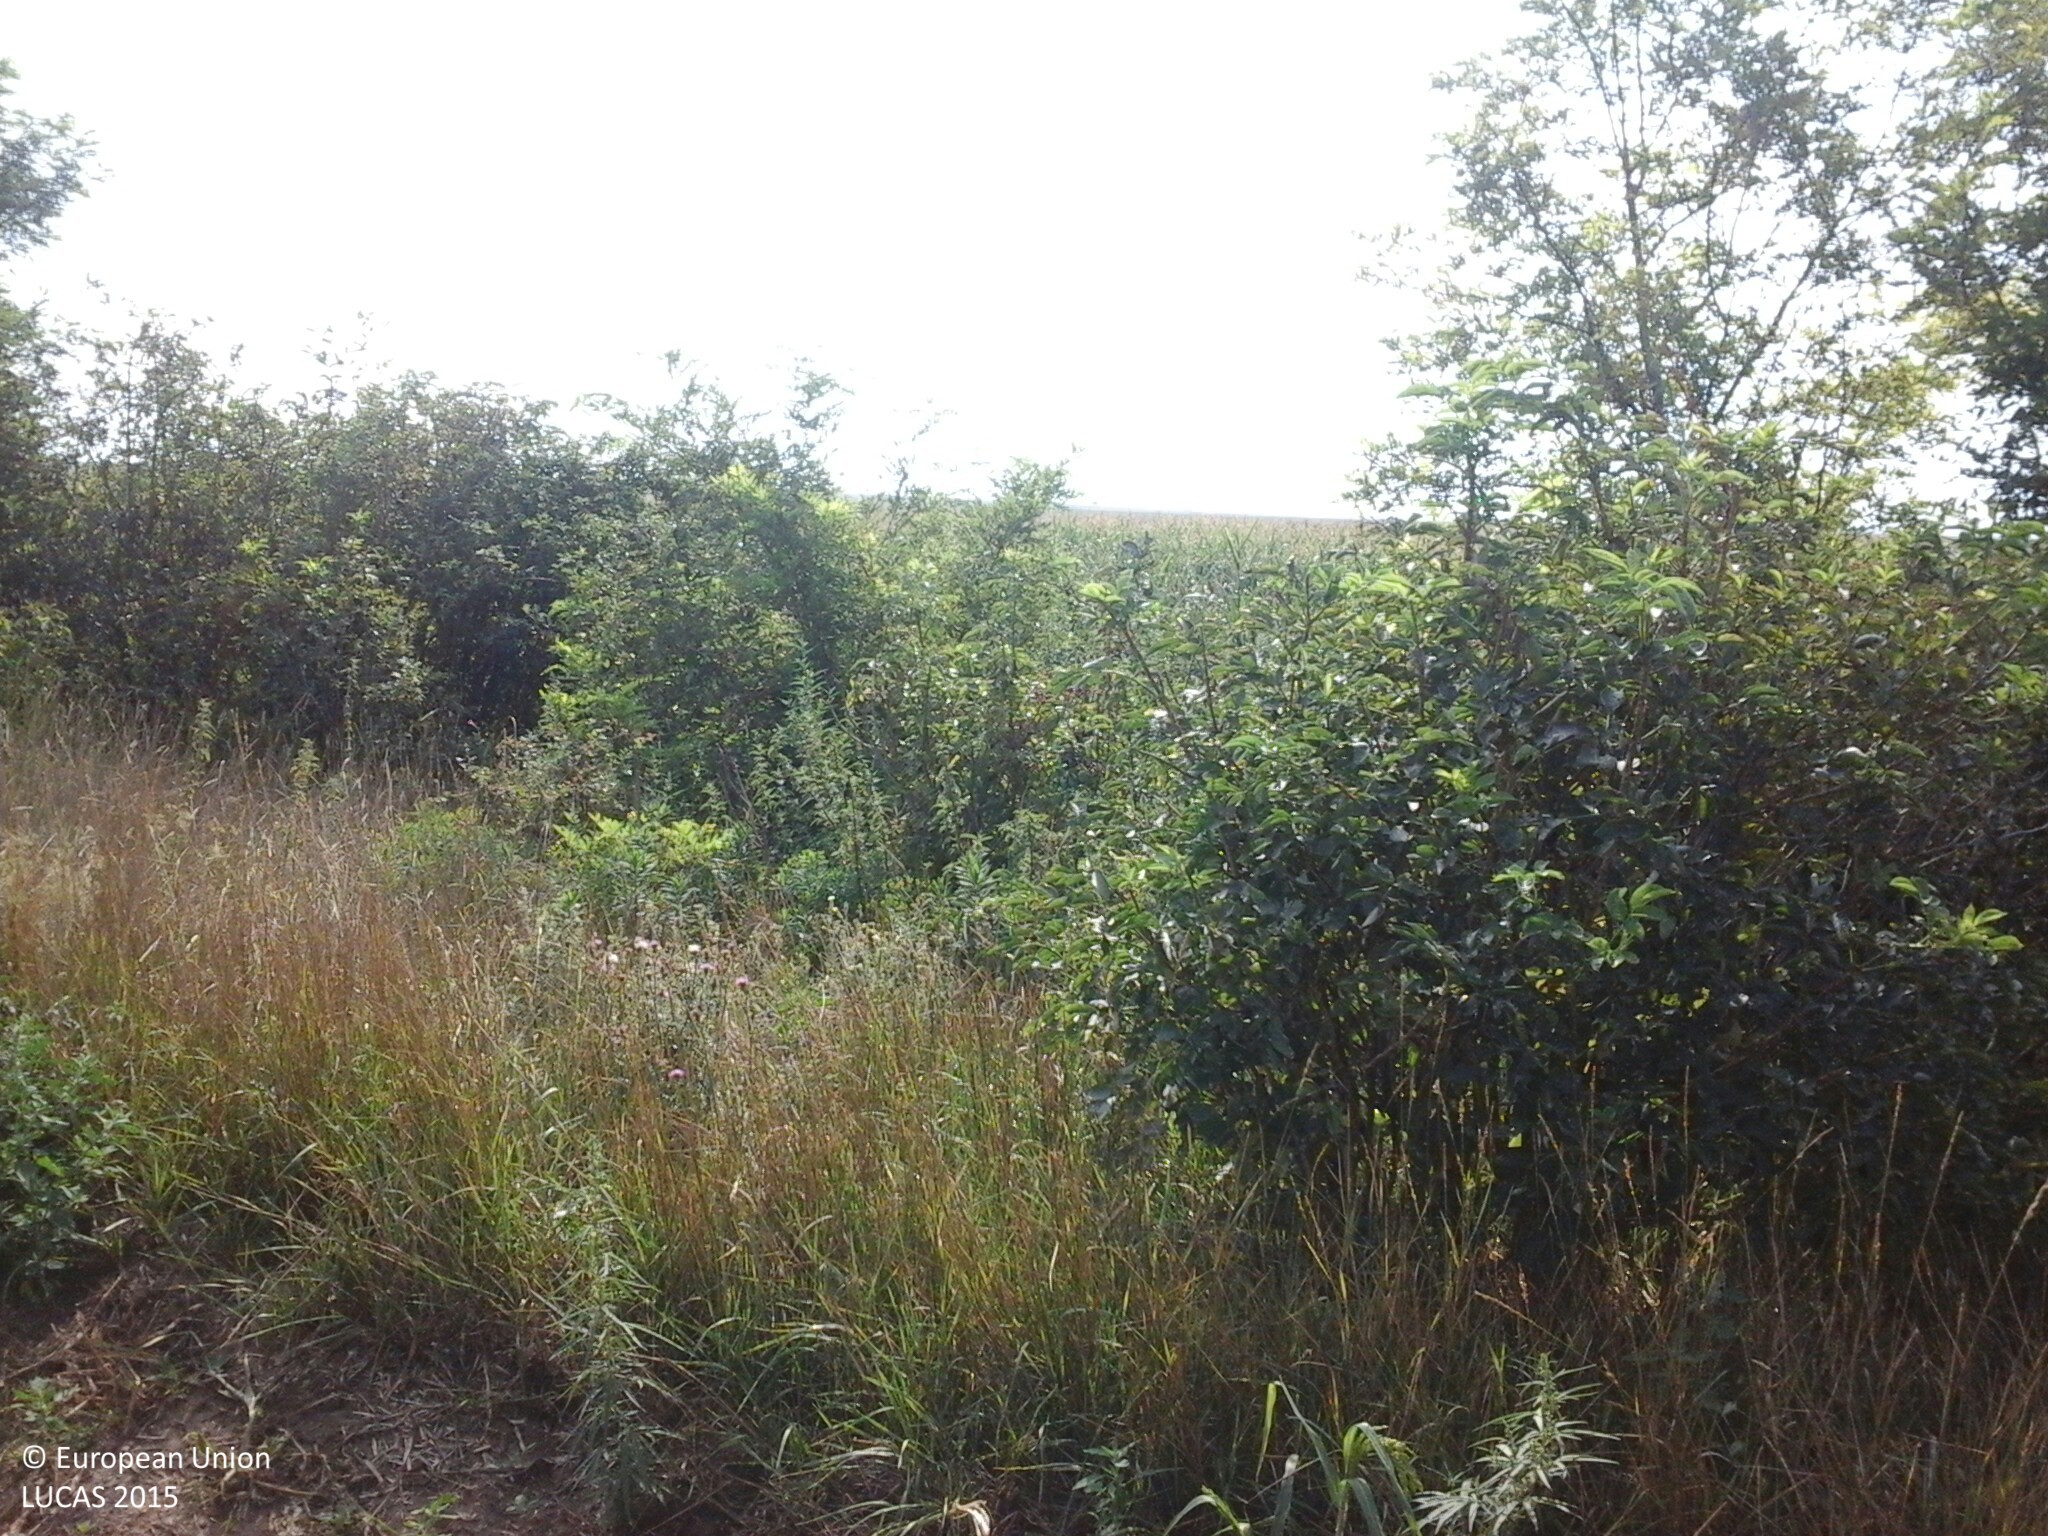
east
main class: Cropland
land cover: Maize
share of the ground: > 75 %
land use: Agriculture (excluding fallow land and kitchen gardens)
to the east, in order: Maize; Grass margins; Shrubland with sparse tree cover; Grass margins; Maize; Grassland without tree/shrub cover
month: August
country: HU
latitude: 47.2888
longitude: 18.3822
